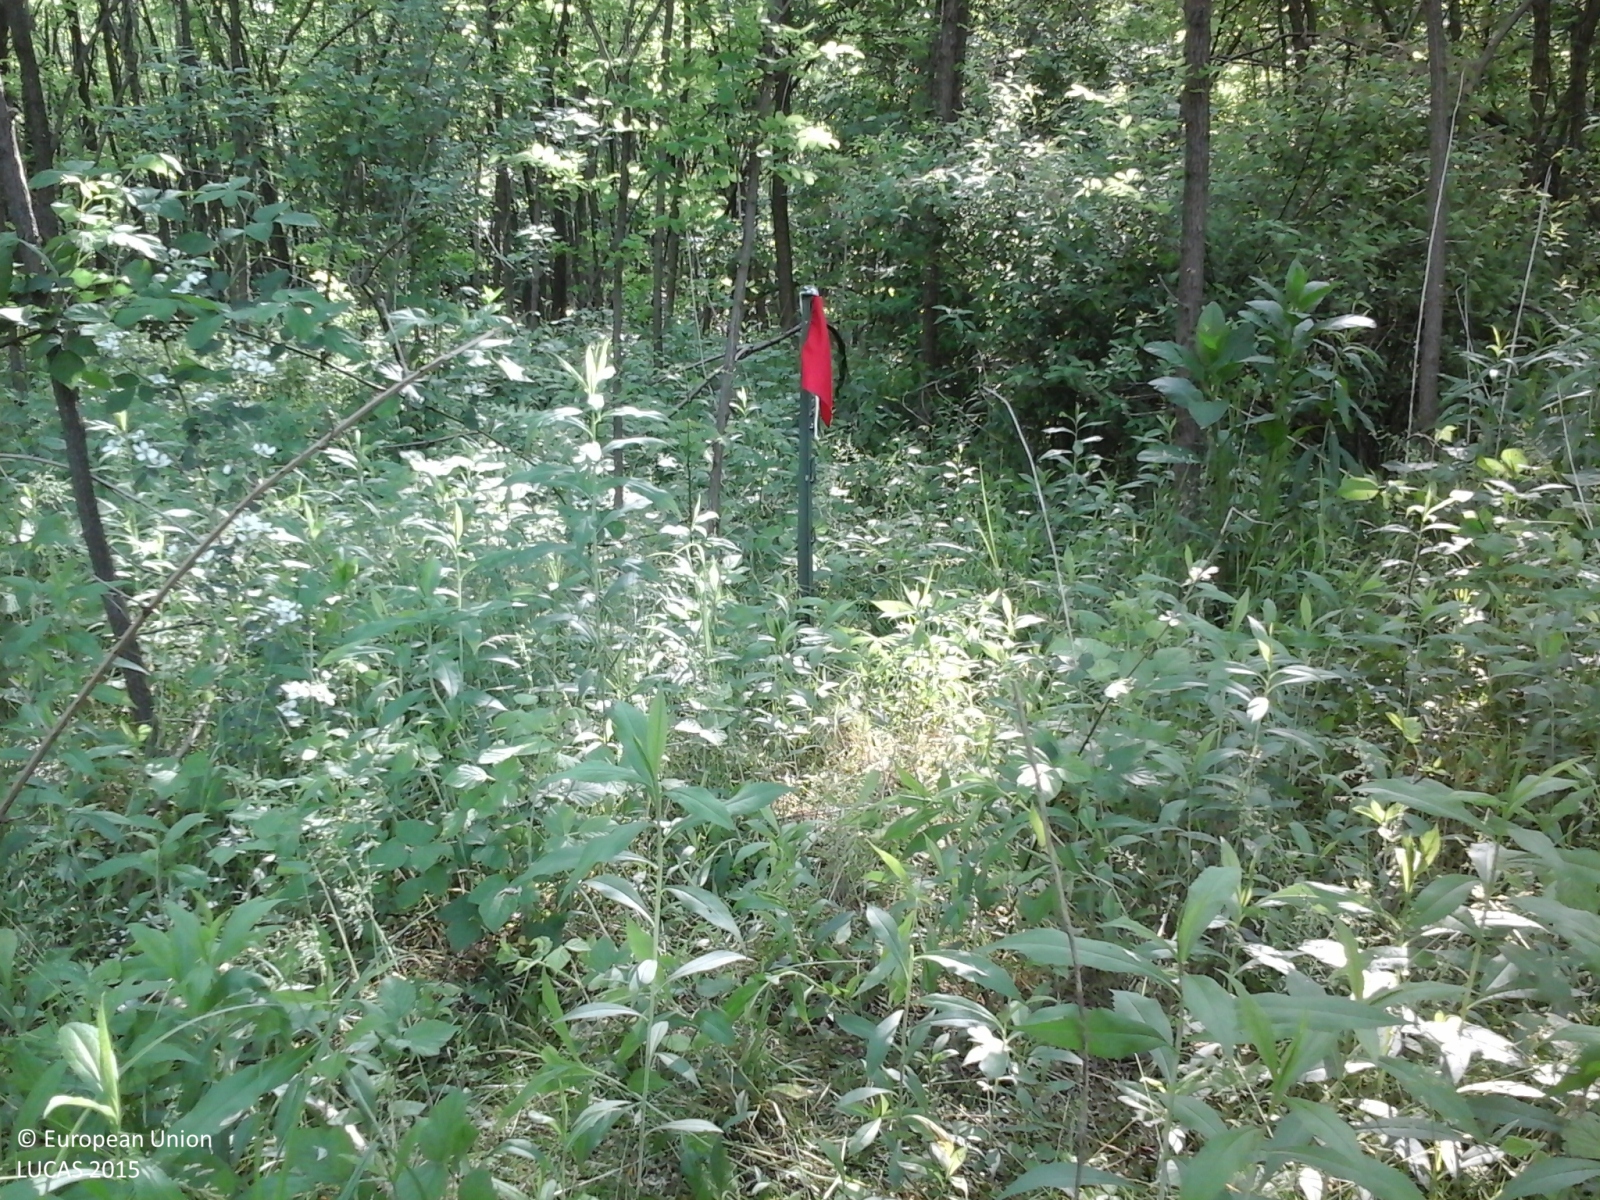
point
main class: Woodland
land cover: Broadleaved woodland
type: mesophytic deciduous forest
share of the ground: > 75 %
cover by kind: broadleaved forest trees 100 %
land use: Forestry
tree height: > 5 m
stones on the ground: < 10 %
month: May
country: IT
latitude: 45.5820
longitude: 8.3749
